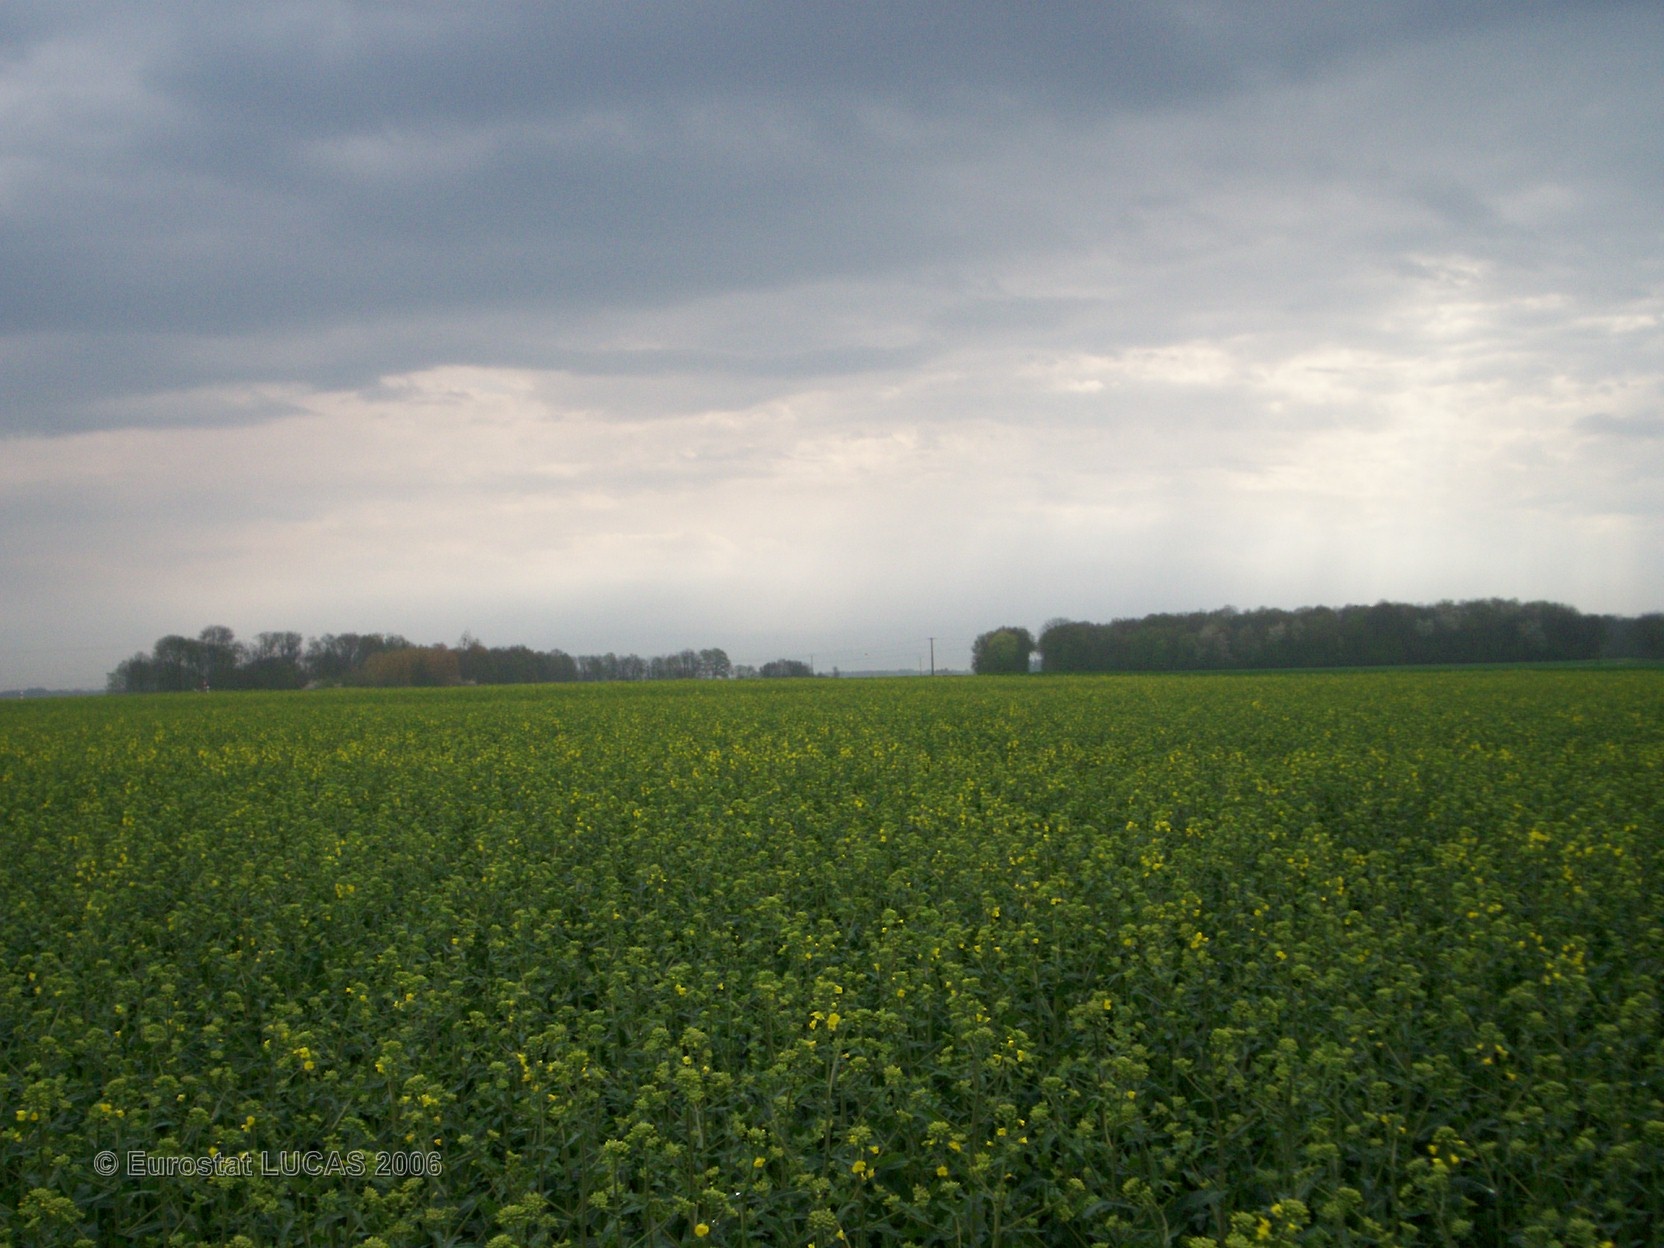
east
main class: Cropland
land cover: Rape and turnip rape
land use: Agriculture (excluding fallow land and kitchen gardens)
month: April
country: FR
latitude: 48.2505
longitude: 2.9485
